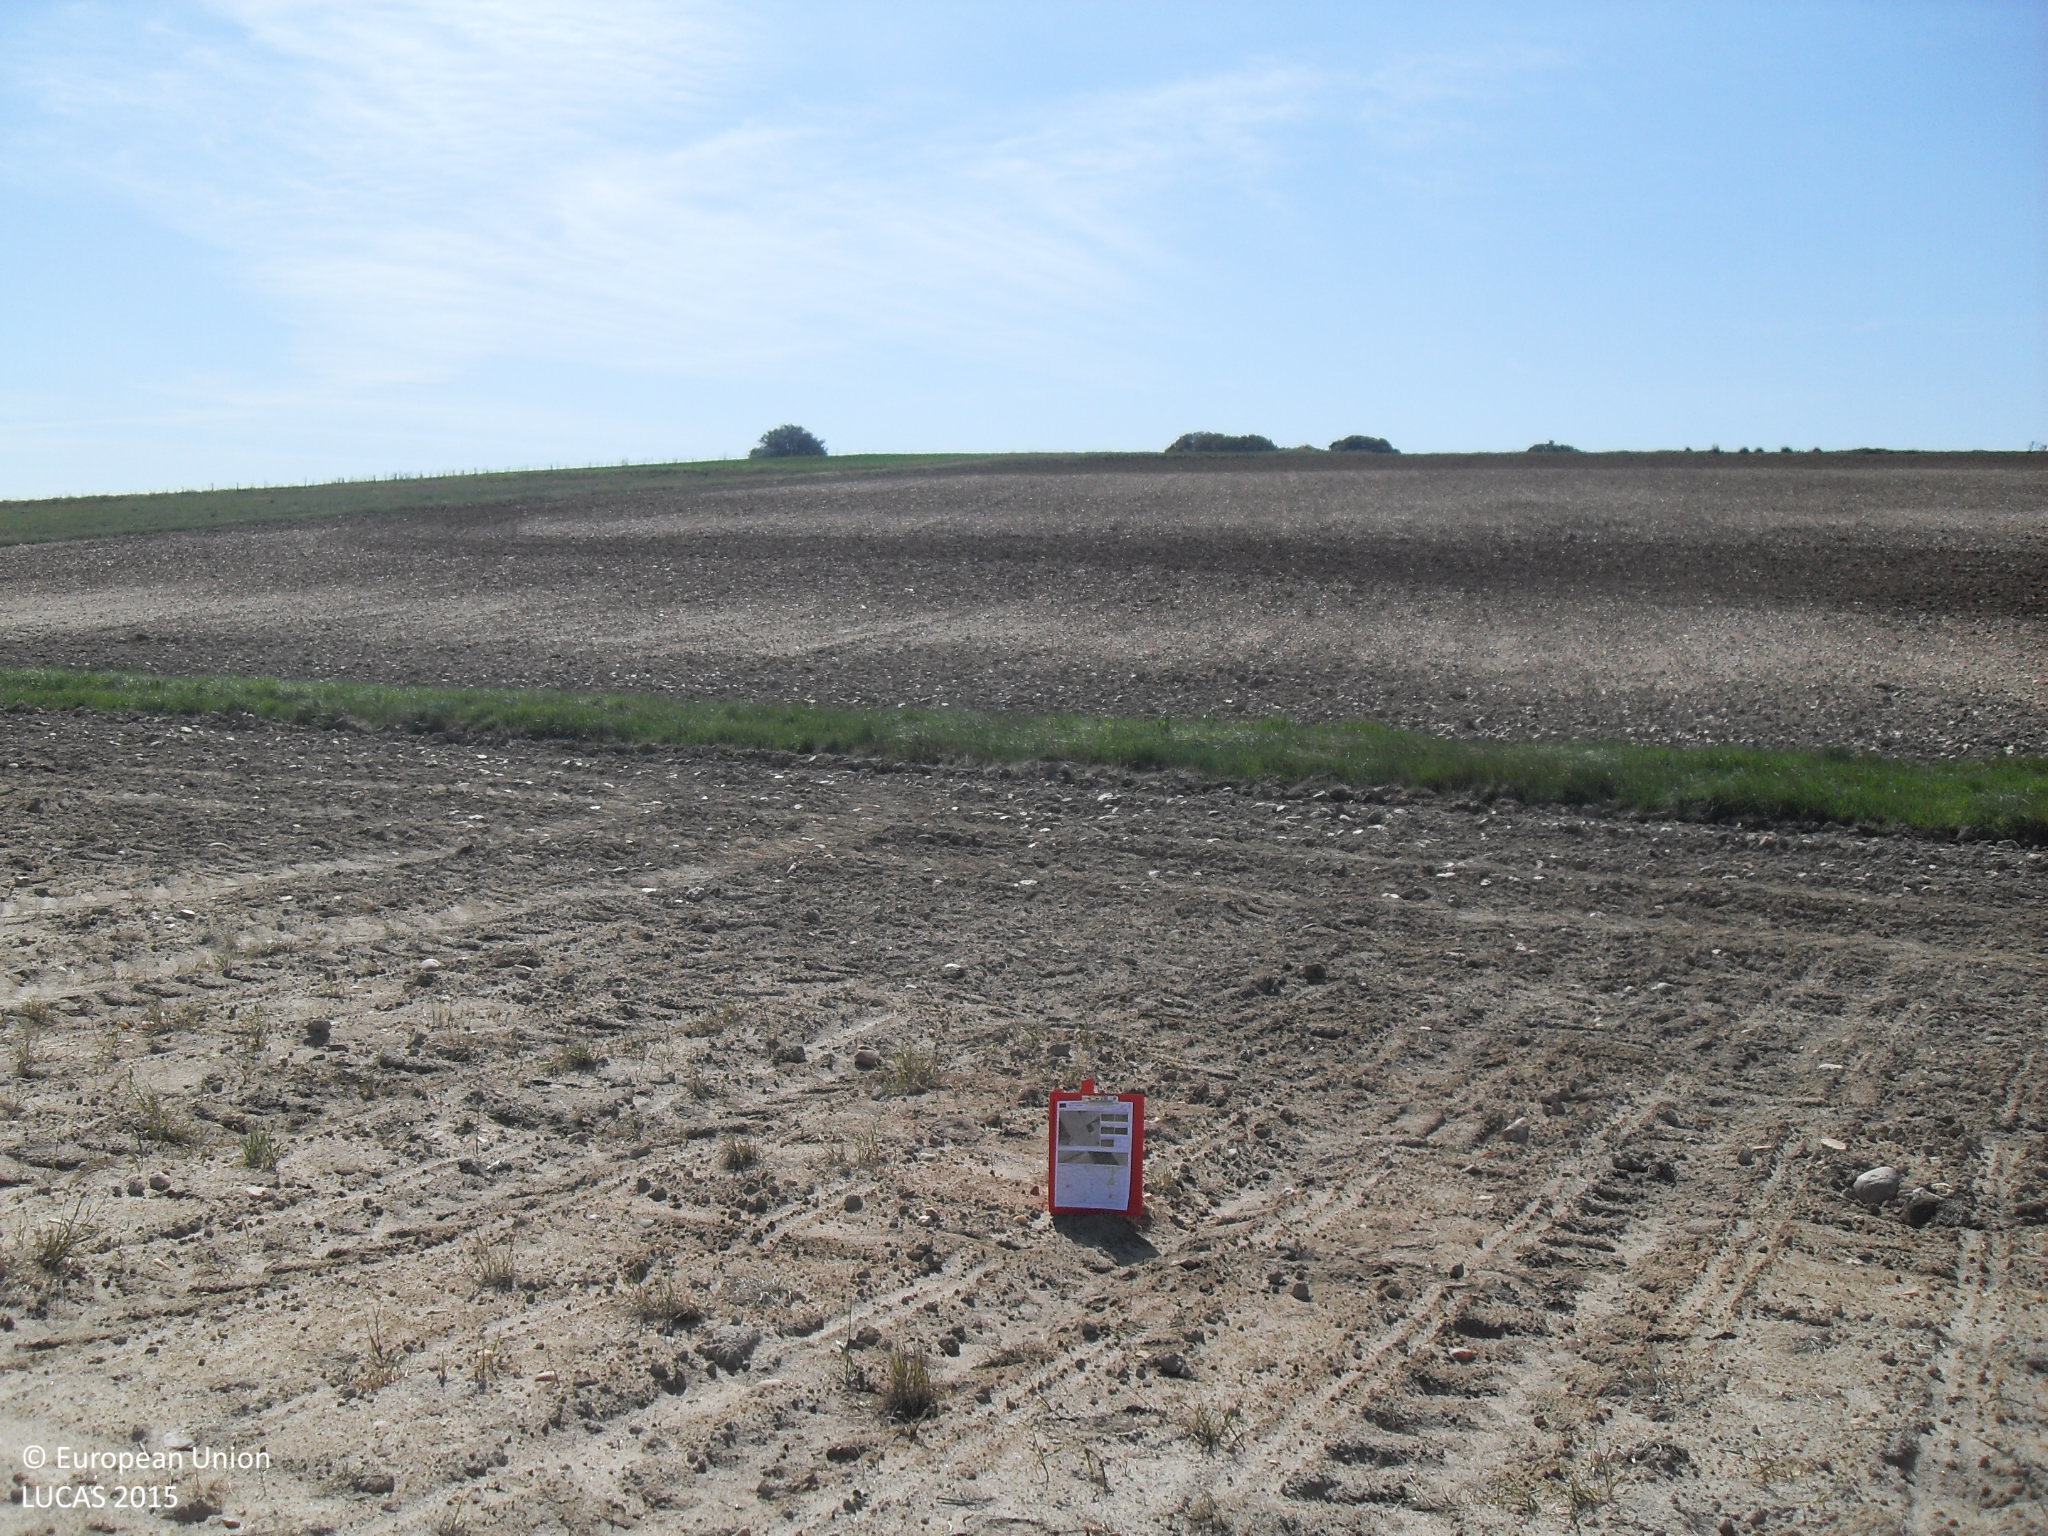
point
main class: Cropland
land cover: Sunflower
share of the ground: > 75 %
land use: Agriculture (excluding fallow land and kitchen gardens)
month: May
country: ES
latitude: 40.8050
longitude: -5.1792
